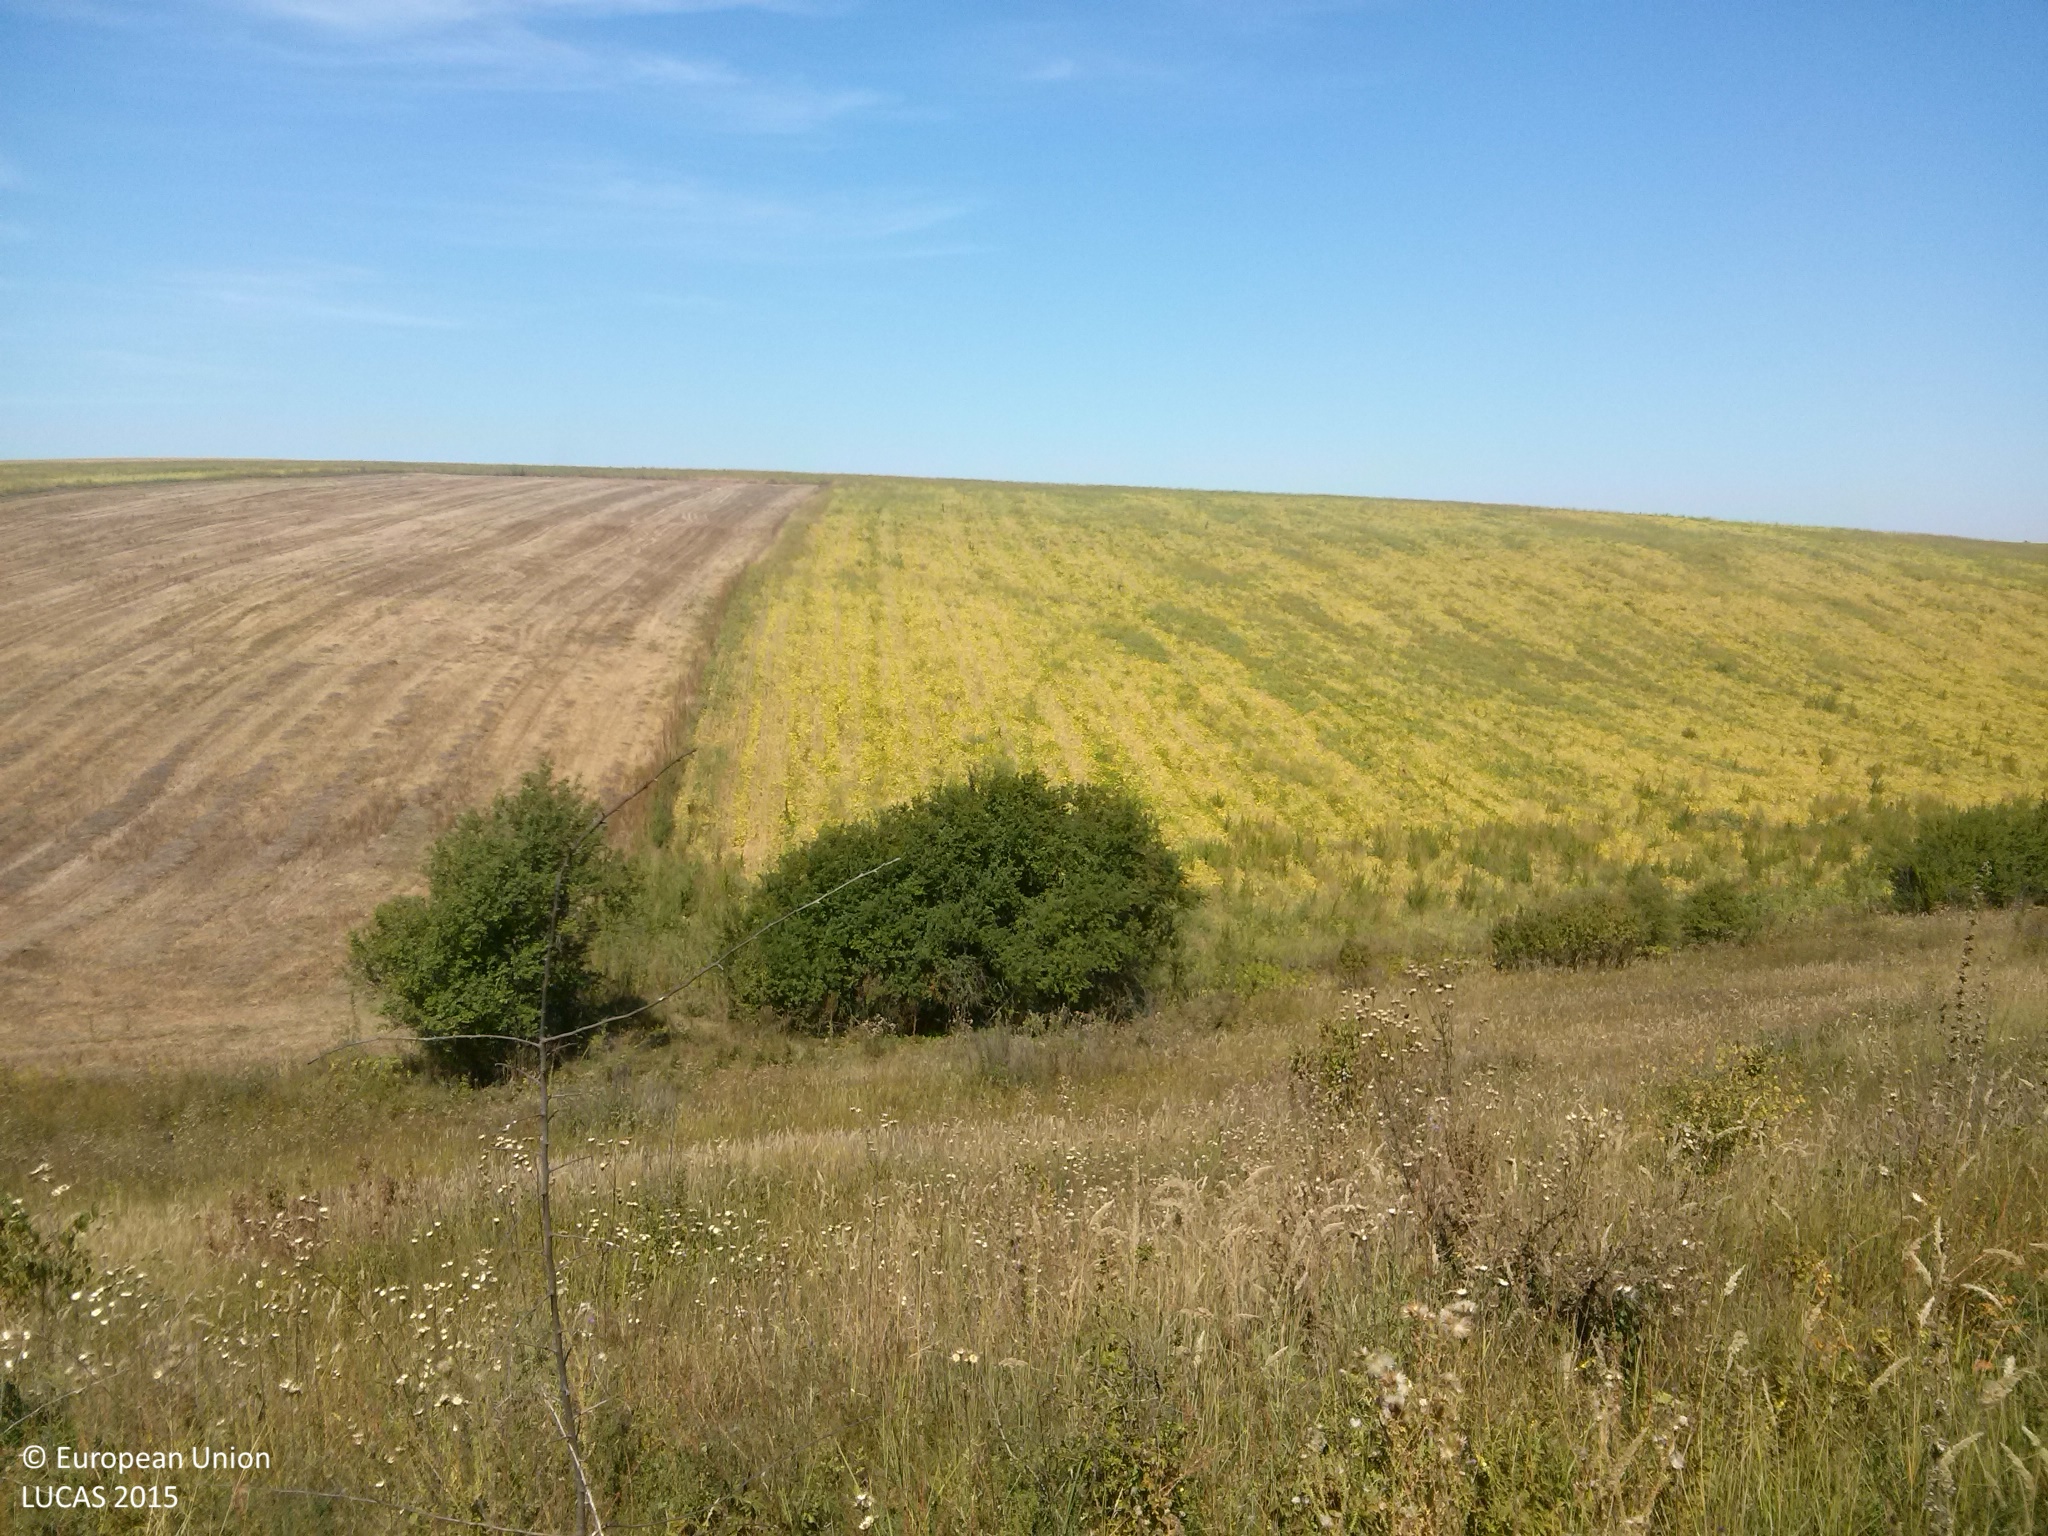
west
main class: Grassland
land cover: Grassland with sparse tree/shrub cover
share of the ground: > 75 %
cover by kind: herbaceous plants 95 %, broadleaved forest trees 5 %
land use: Agriculture (excluding fallow land and kitchen gardens)
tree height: < 5 m
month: September
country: BG
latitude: 43.7147
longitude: 26.4010
